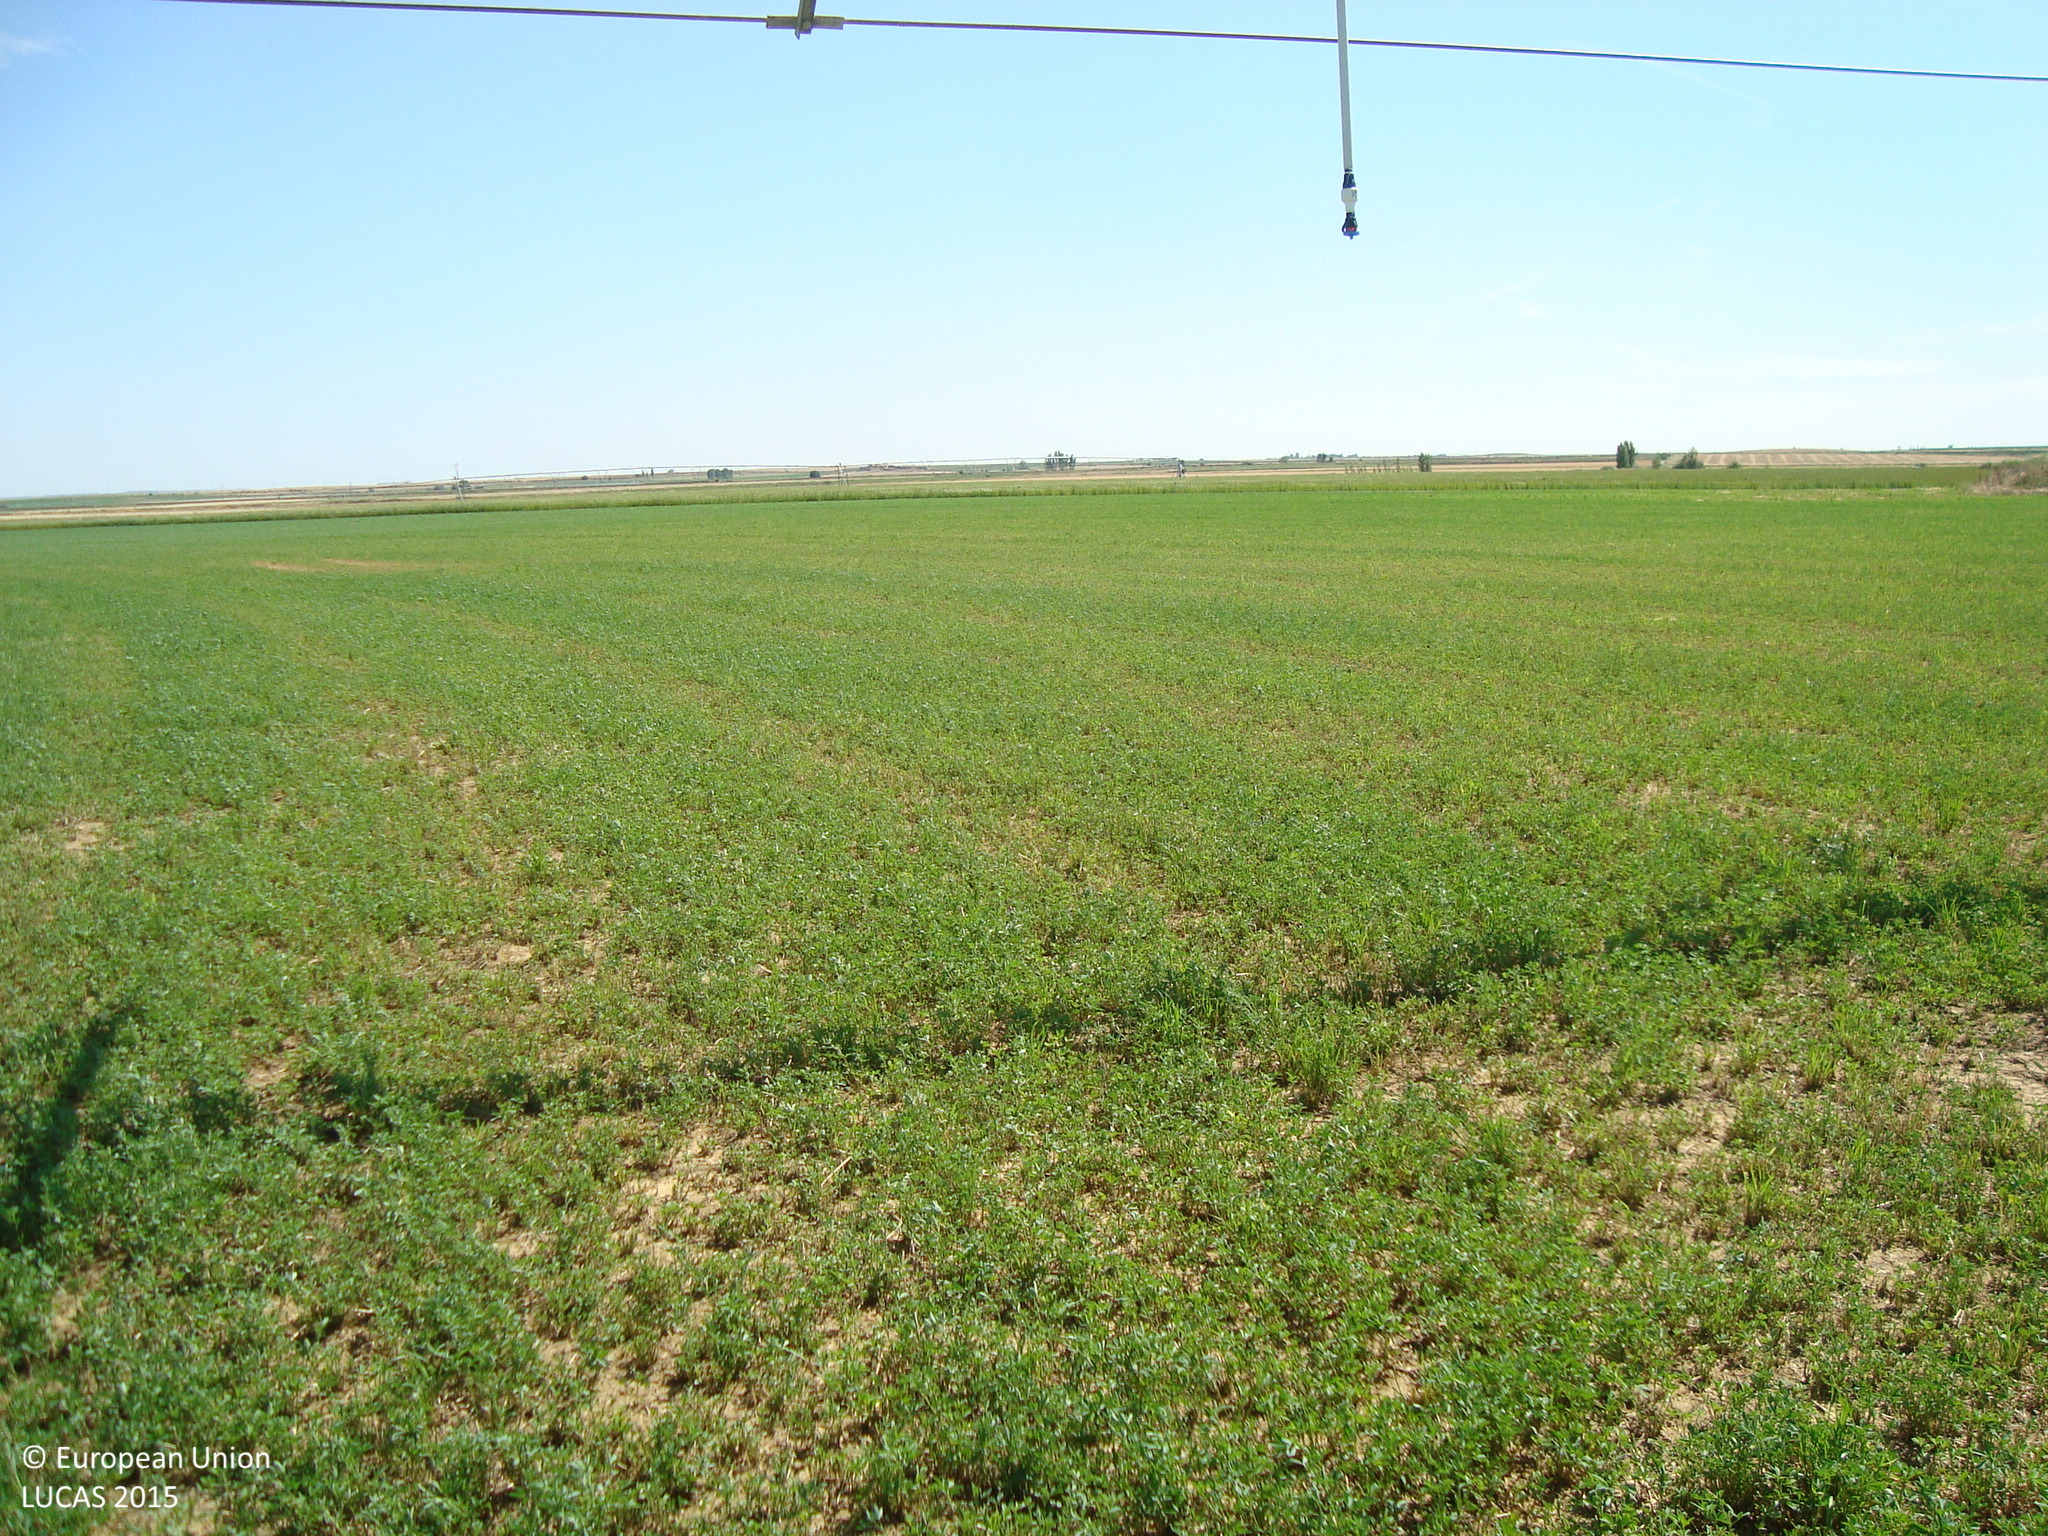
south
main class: Cropland
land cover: Lucerne
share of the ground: > 75 %
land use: Agriculture (excluding fallow land and kitchen gardens)
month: July
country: ES
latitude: 42.1354
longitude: -4.7510
